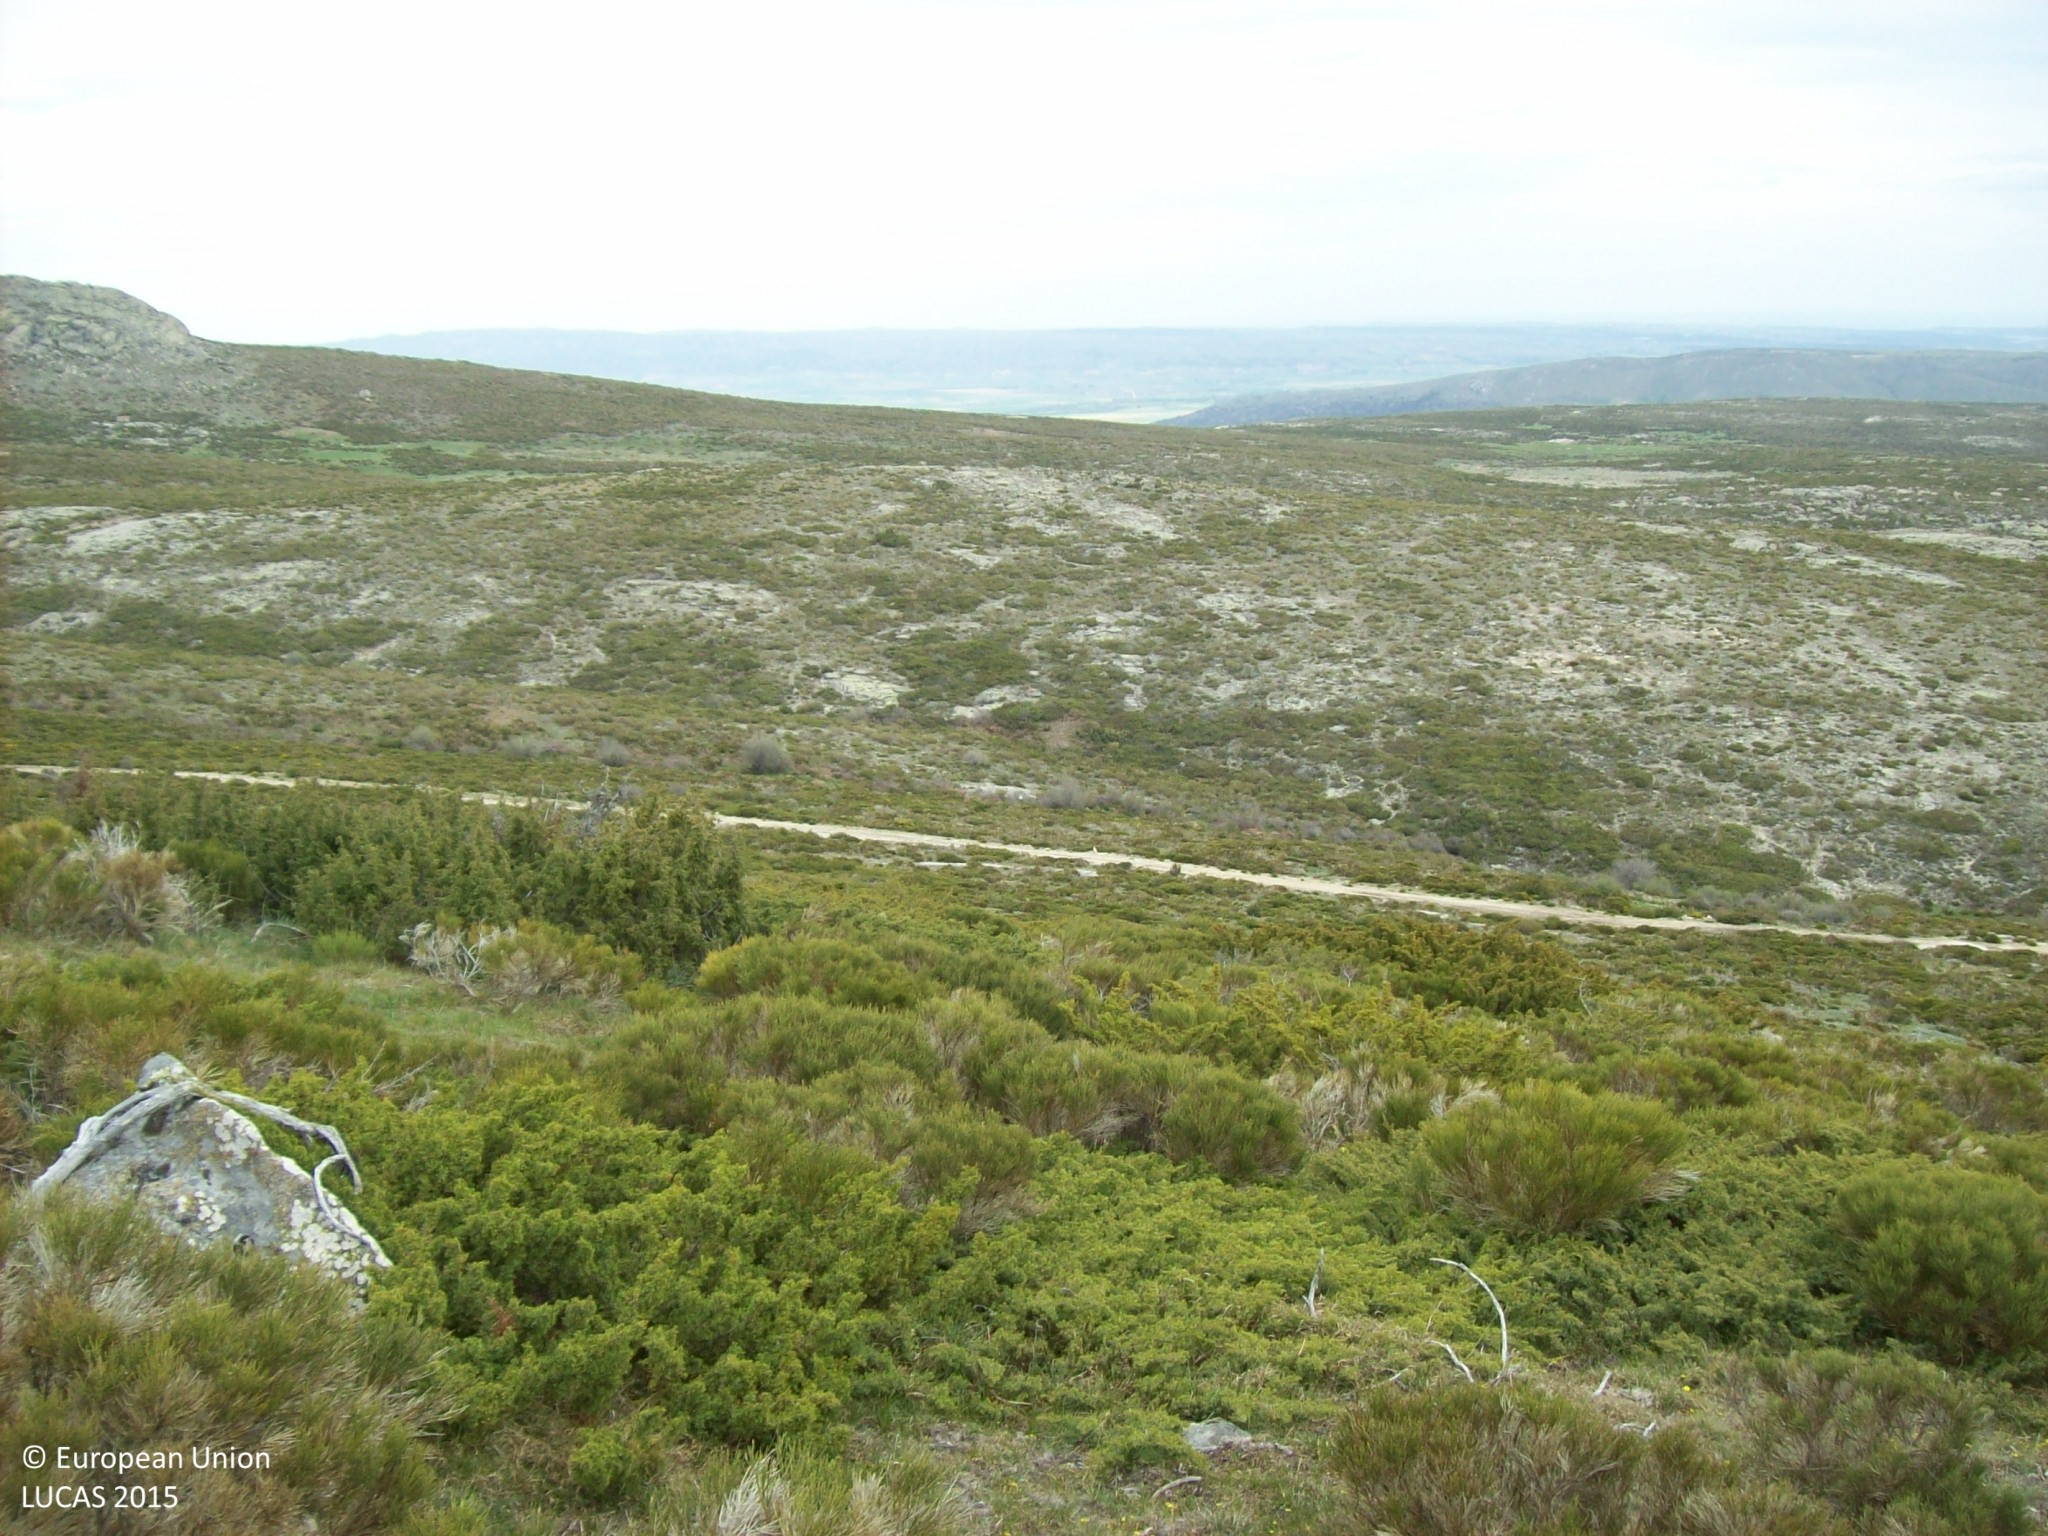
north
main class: Shrubland
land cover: Shrubland without tree cover
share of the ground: 25 - 50 %
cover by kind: herbaceous plants 50 %, shrubs 45 %, consolidated bare surface 5 %
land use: Agriculture (excluding fallow land and kitchen gardens)
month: May
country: ES
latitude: 40.4938
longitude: -4.8154
